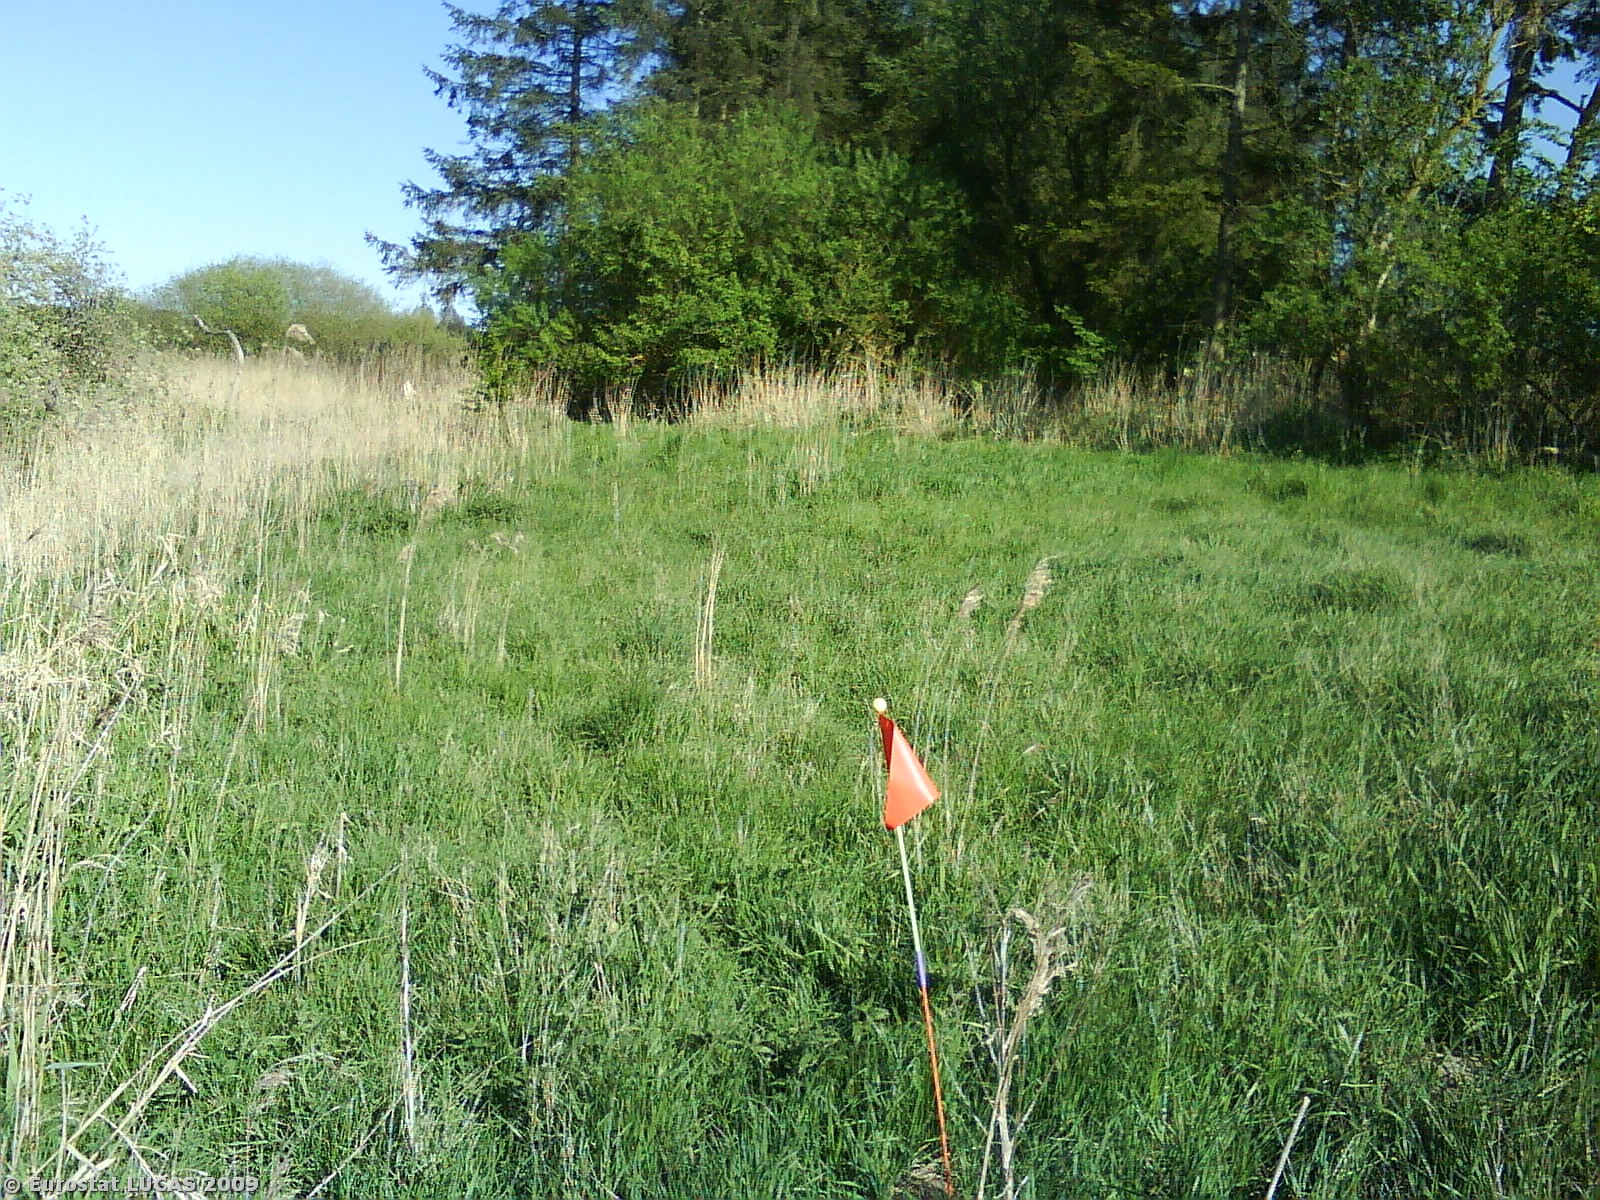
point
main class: Grassland
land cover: Grassland without tree/shrub cover
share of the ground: > 75 %
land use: Unused
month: May
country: DK
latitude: 56.4012
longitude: 10.7606
